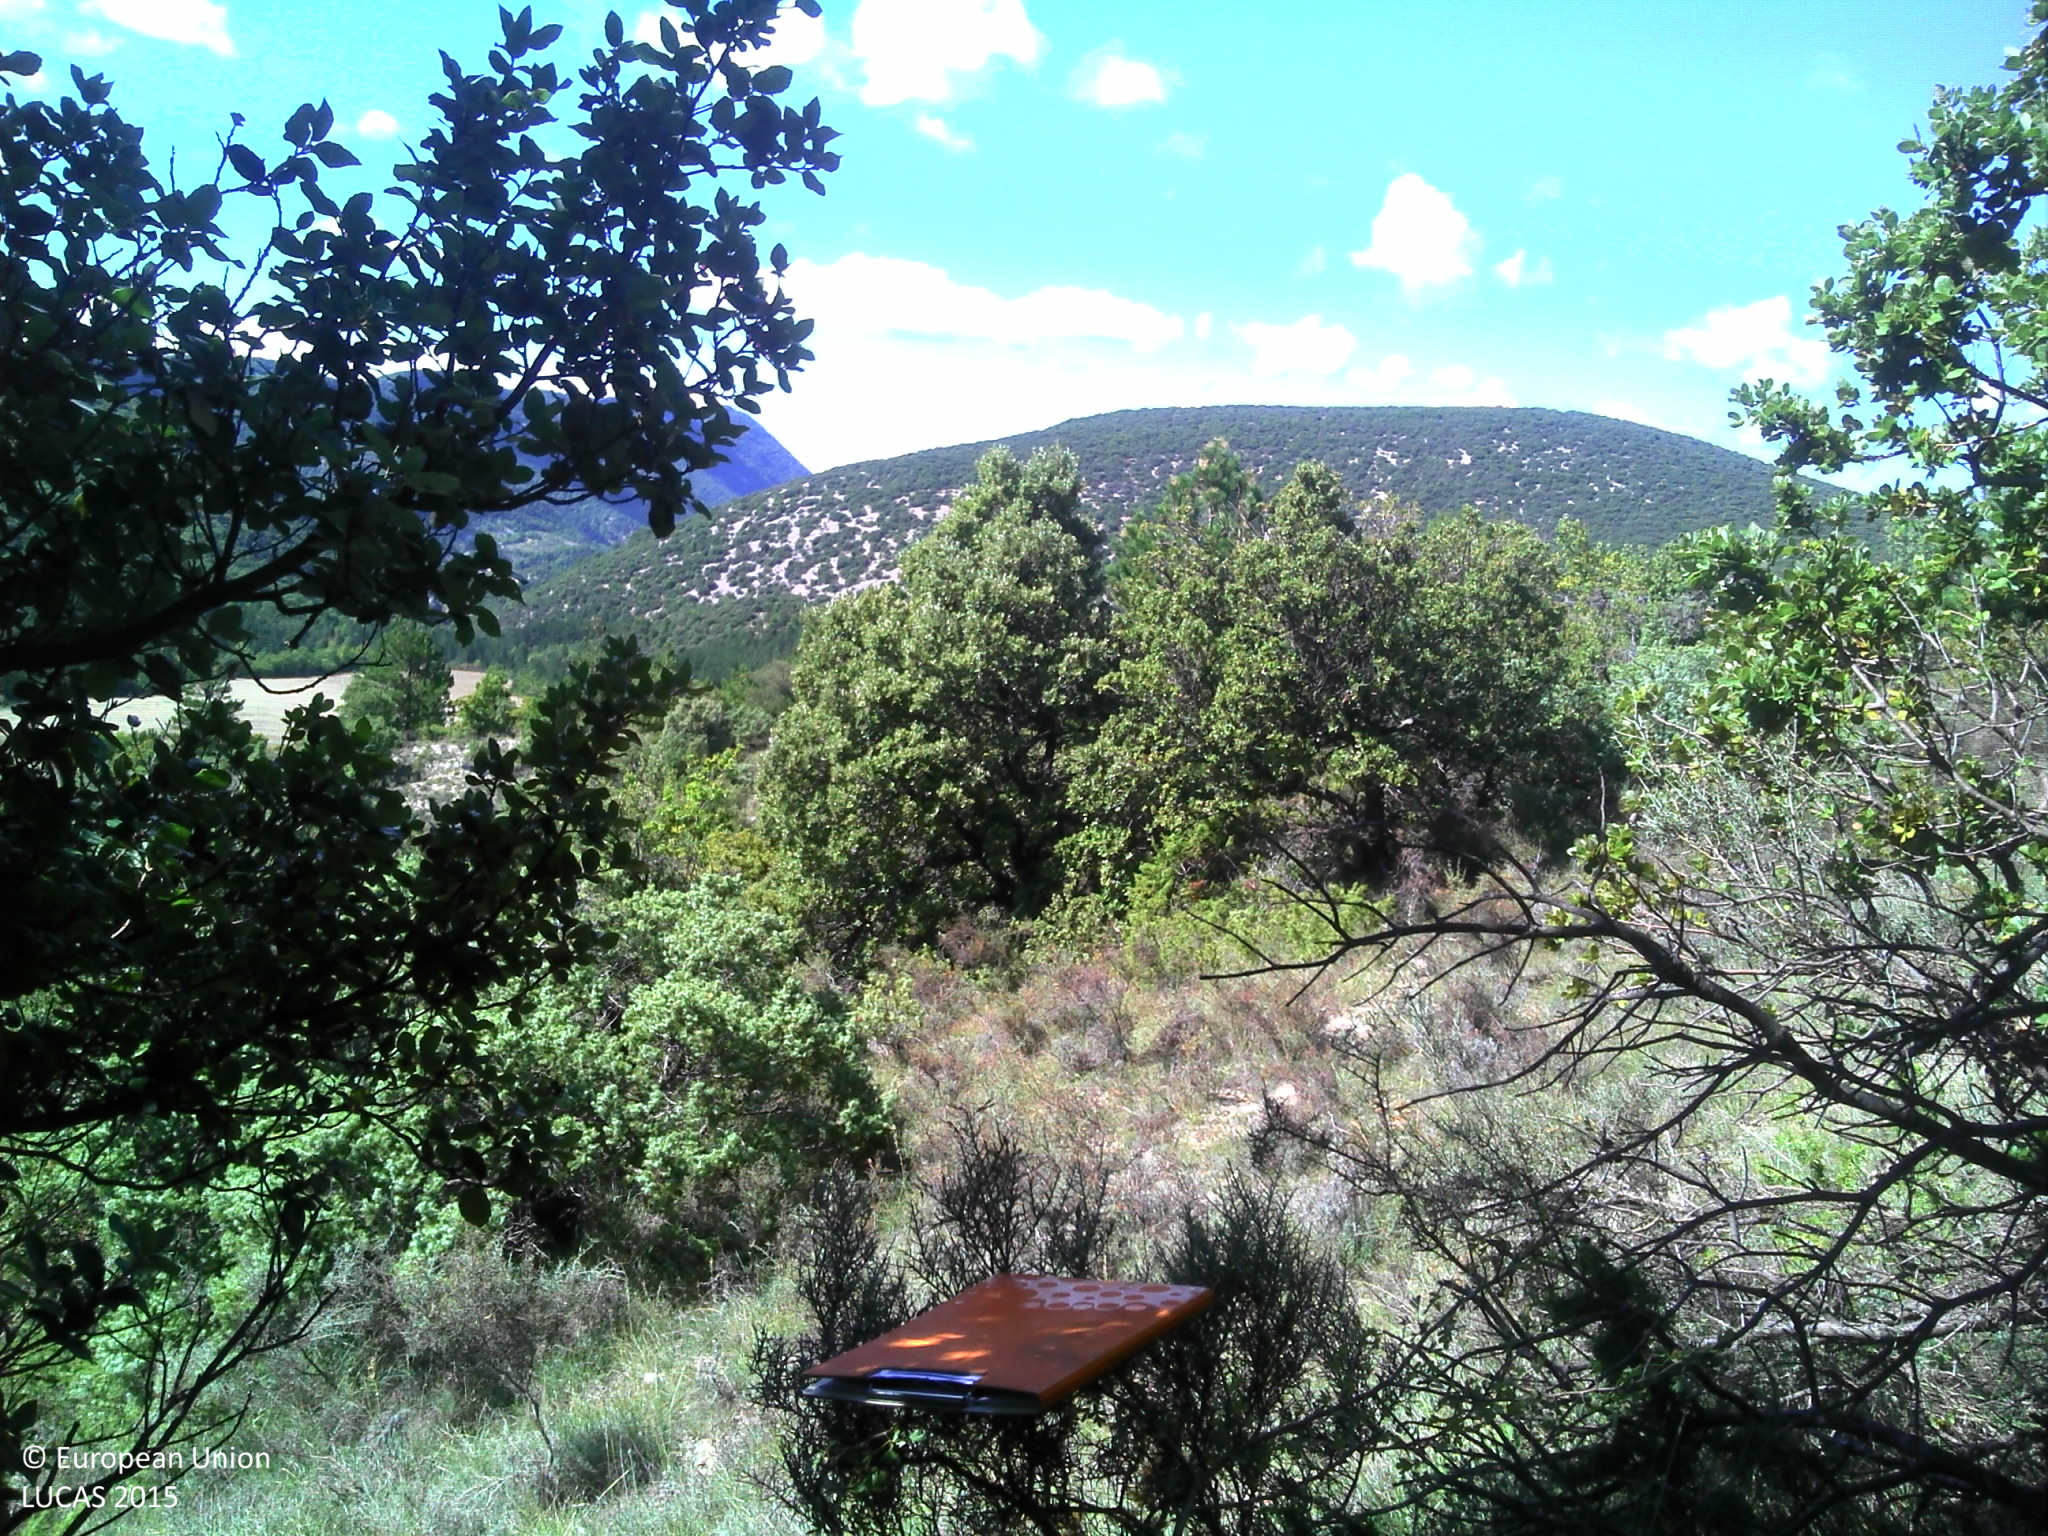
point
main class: Woodland
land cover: Pine dominated mixed woodland
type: coniferous forest of the mediterranean region
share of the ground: 50 - 75 %
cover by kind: shrubs 55 %, broadleaved forest trees 25 %, coniferous forest trees 20 %
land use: Agriculture (excluding fallow land and kitchen gardens)
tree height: < 5 m
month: September
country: FR
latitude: 44.2098
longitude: 5.3397
